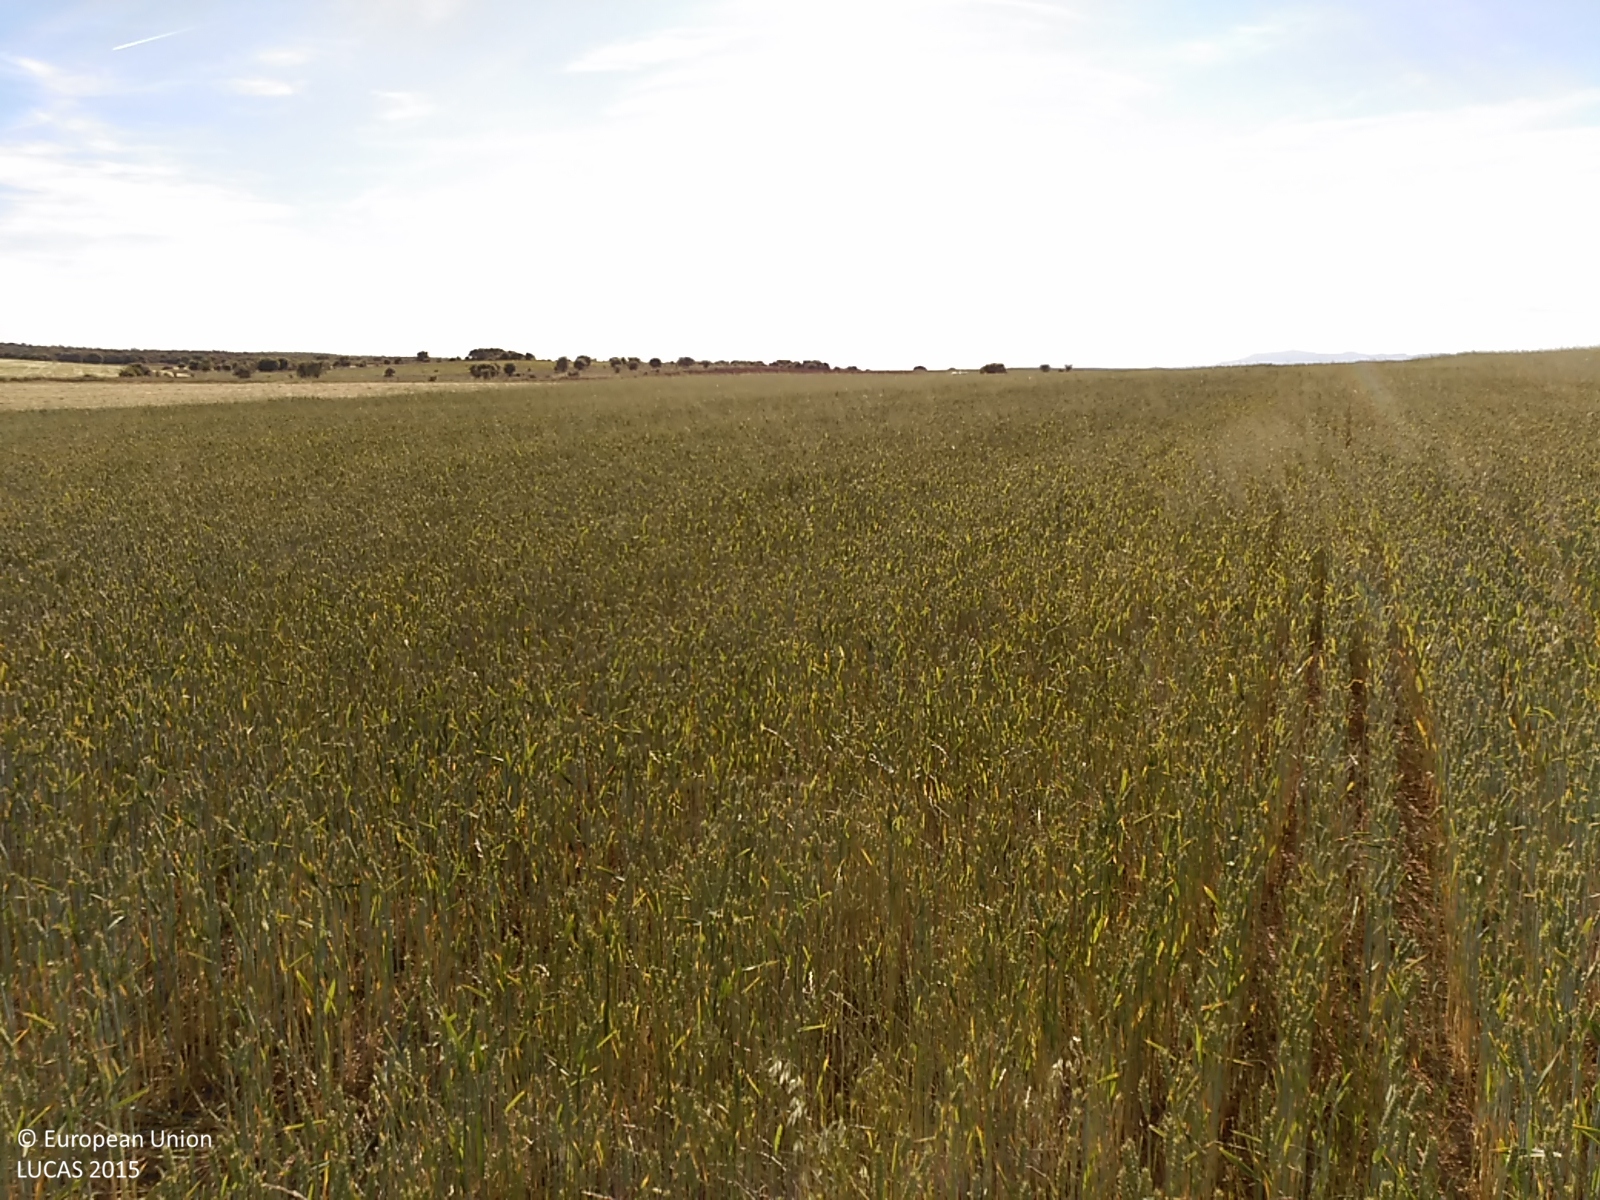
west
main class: Cropland
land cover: Common wheat
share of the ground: > 75 %
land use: Agriculture (excluding fallow land and kitchen gardens)
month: May
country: ES
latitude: 42.0581
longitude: -5.9646
